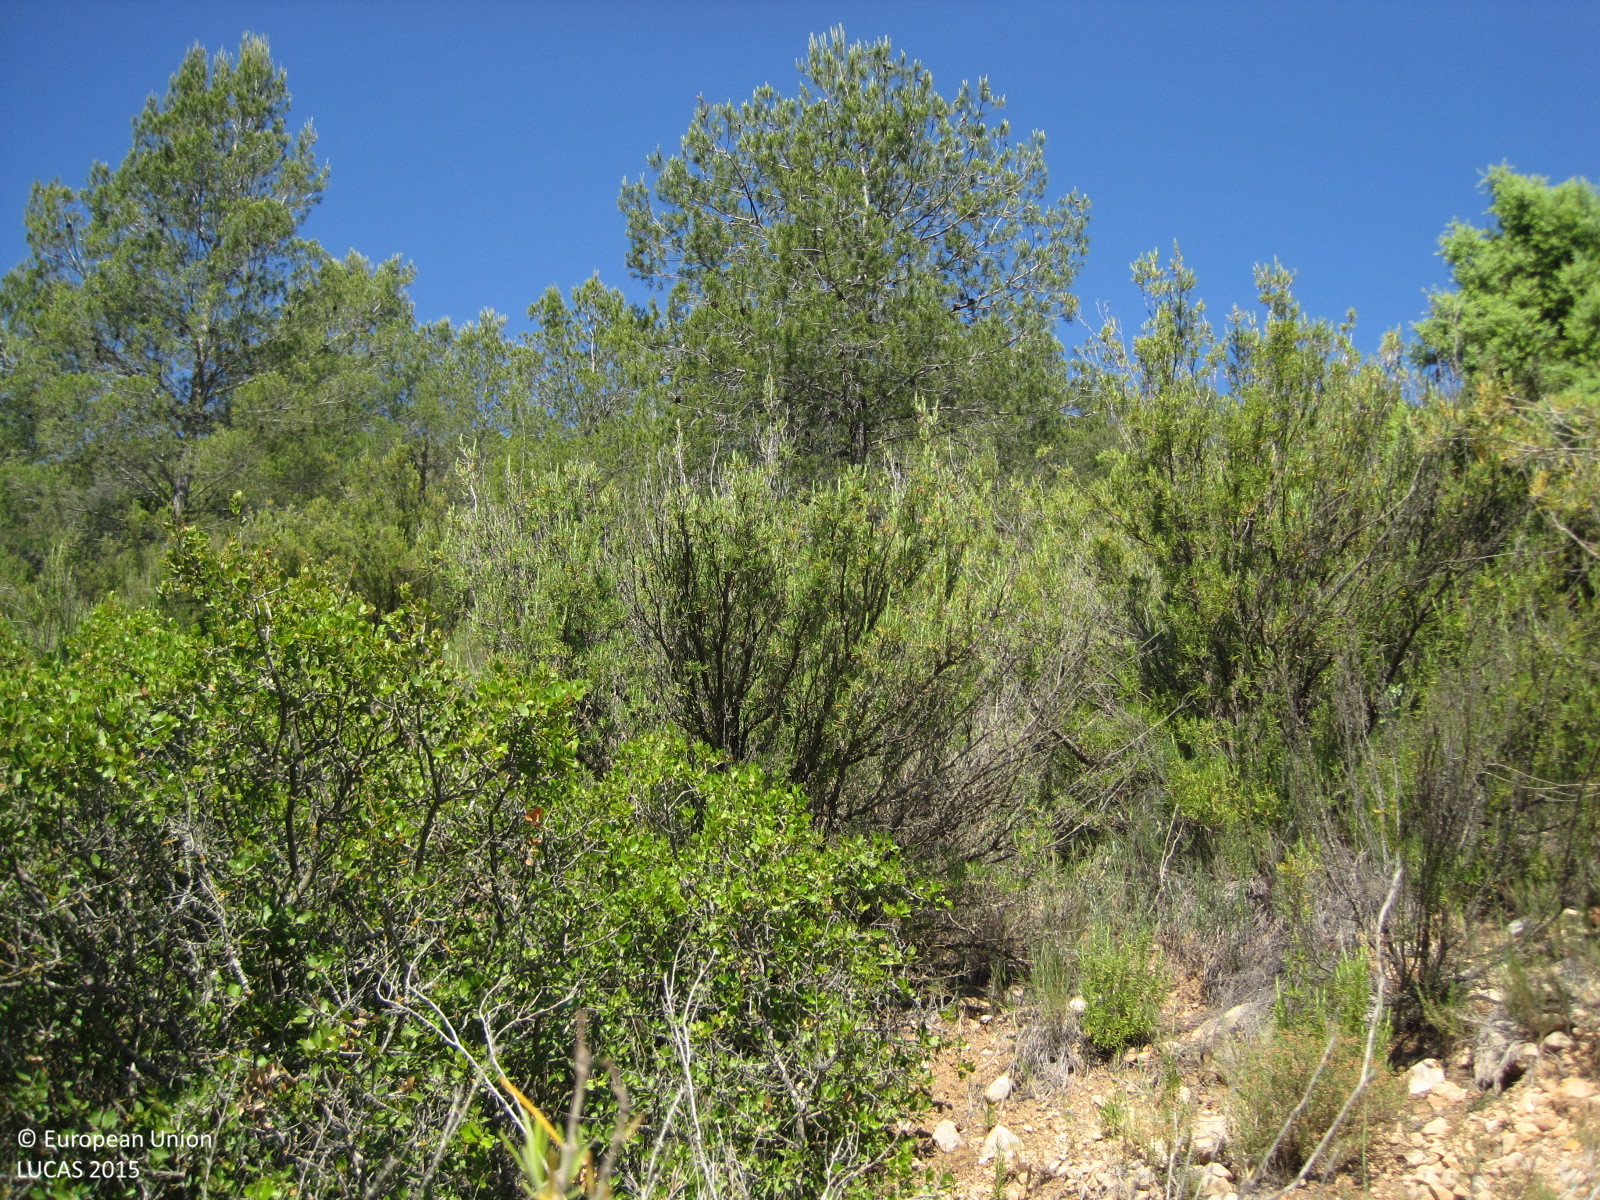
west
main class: Woodland
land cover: Pine dominated coniferous woodland
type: coniferous forest of the mediterranean region
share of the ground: 10 - 25 %
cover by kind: shrubs 50 %, unconsolidated bare surface 20 %, coniferous forest trees 15 %, herbaceous plants 15 %
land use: Forestry
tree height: > 5 m
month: June
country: ES
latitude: 39.7394
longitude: -1.1483
